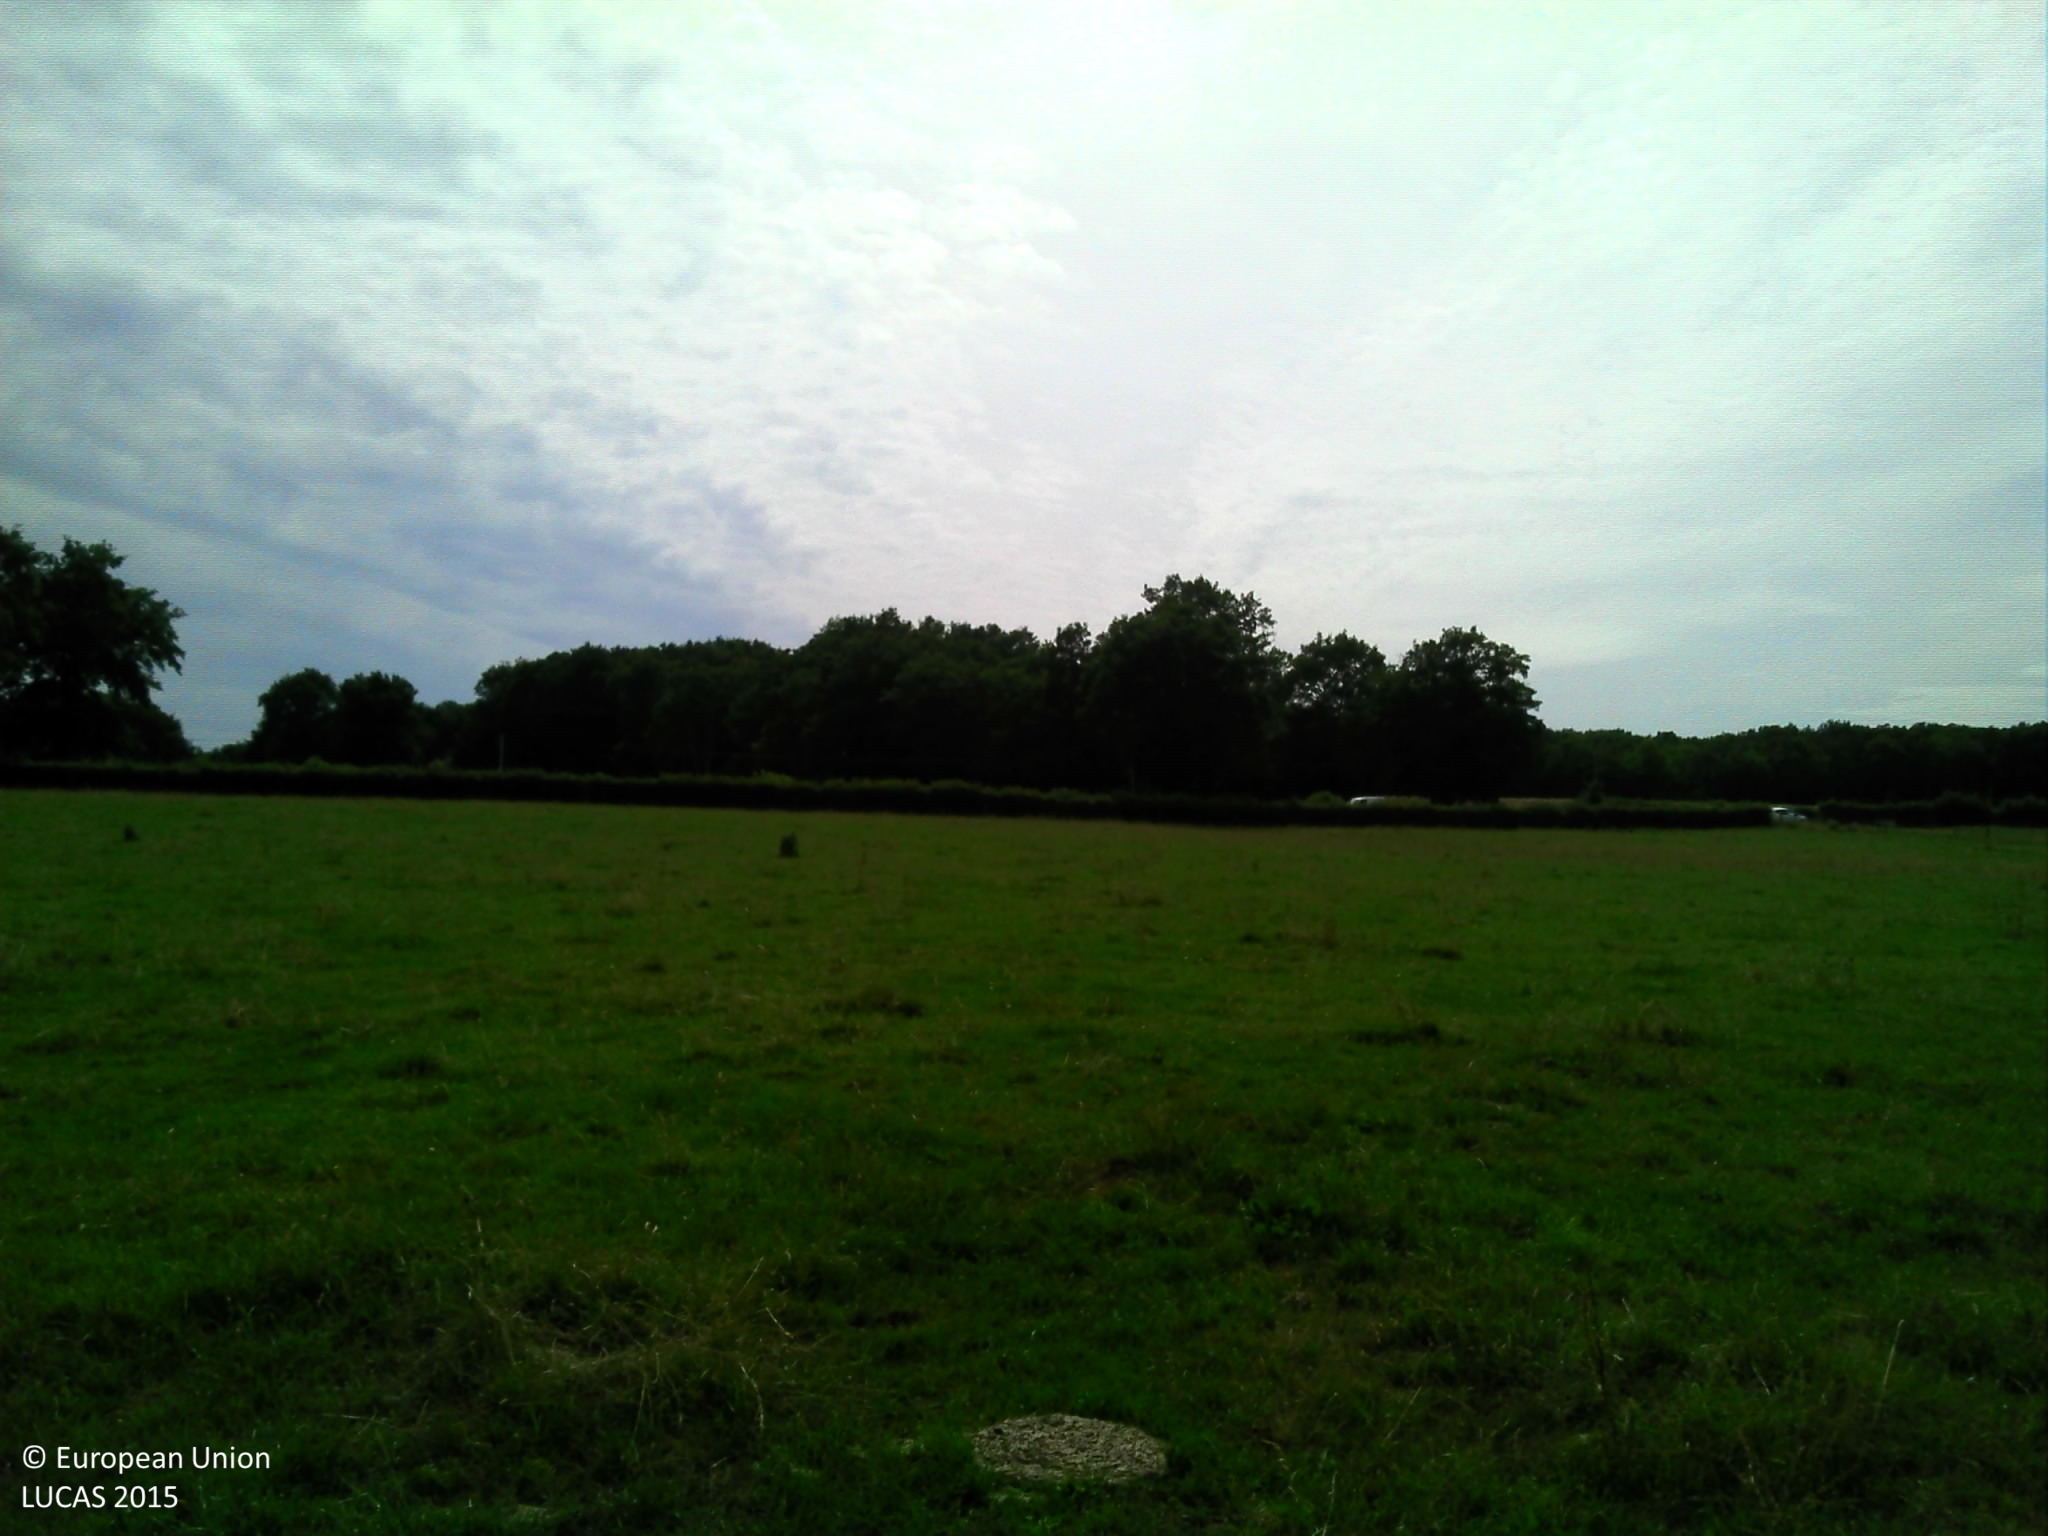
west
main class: Grassland
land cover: Grassland without tree/shrub cover
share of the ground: > 75 %
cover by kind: herbaceous plants 100 %
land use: Agriculture (excluding fallow land and kitchen gardens)
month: June
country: FR
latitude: 46.4805
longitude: 3.2378
